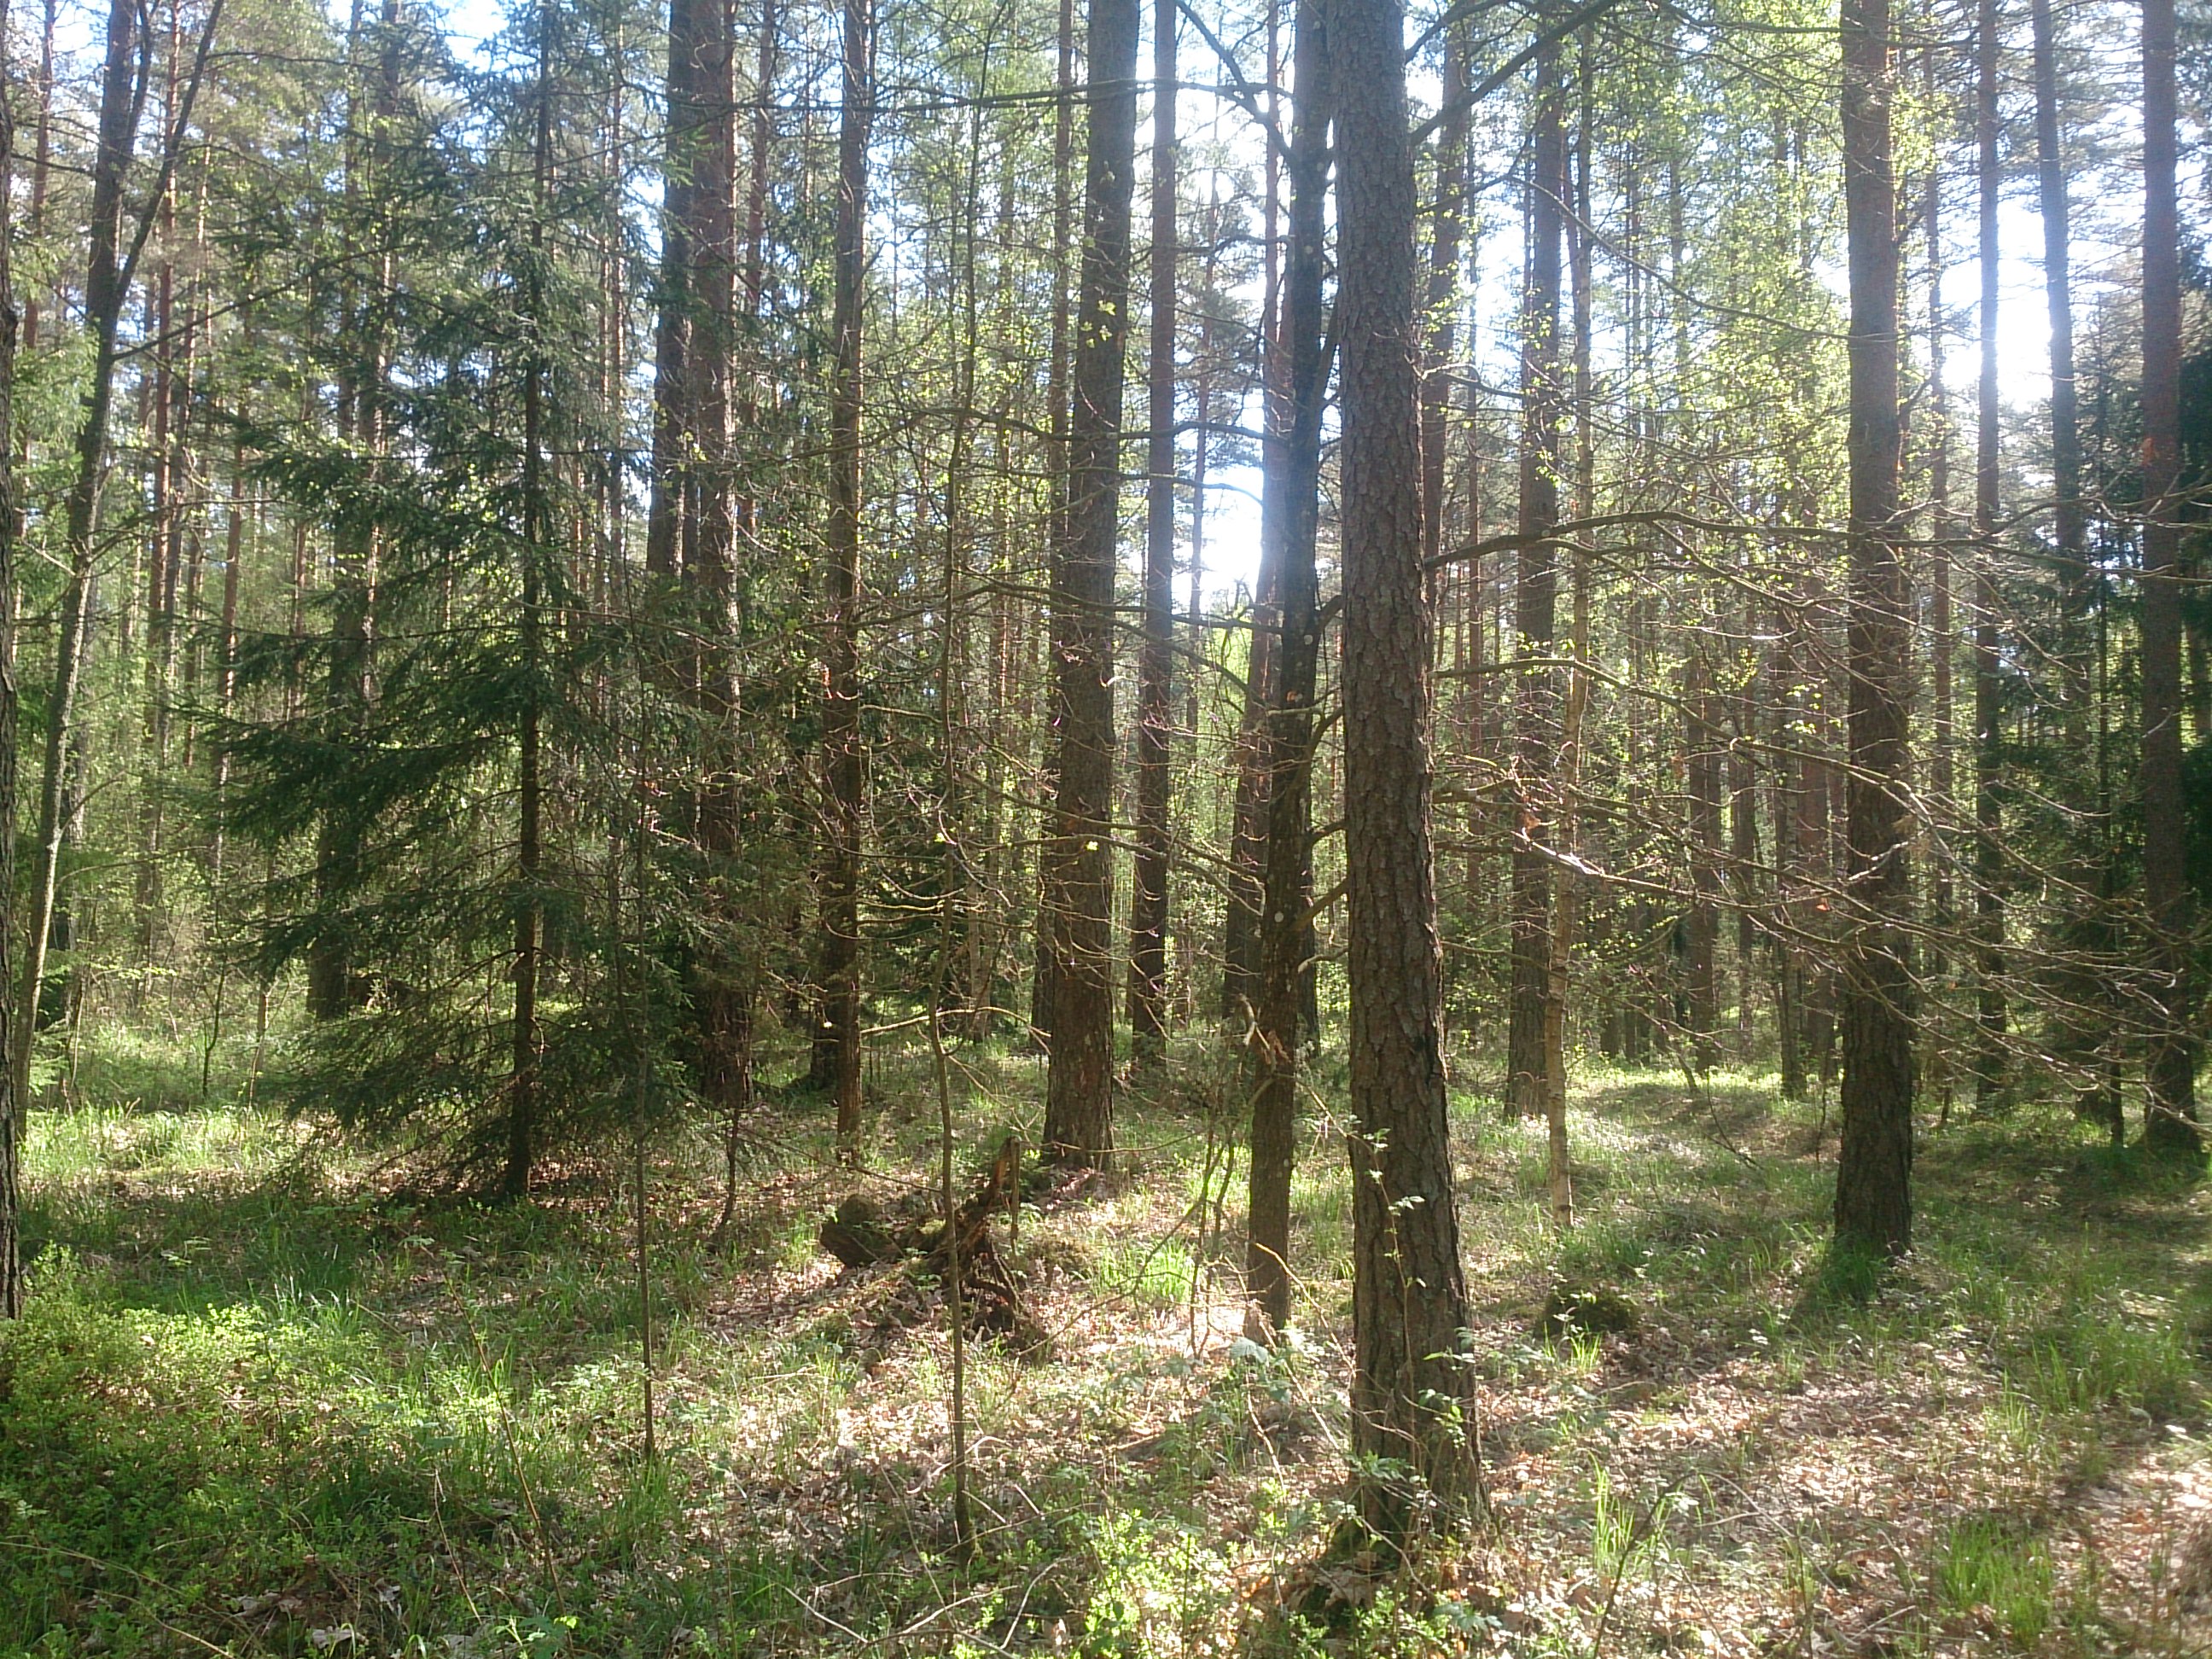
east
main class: Woodland
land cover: Pine dominated coniferous woodland
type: hemiboreal forest and nemoral coniferous forest and mixed broadleaved-coniferous forest
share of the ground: > 75 %
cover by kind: coniferous forest trees 95 %, broadleaved forest trees 5 %
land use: Forestry
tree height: > 5 m
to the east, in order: Pine dominated coniferous woodland; Tracks; Pine dominated coniferous woodland
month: May
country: LV
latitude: 56.7531
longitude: 24.3025
